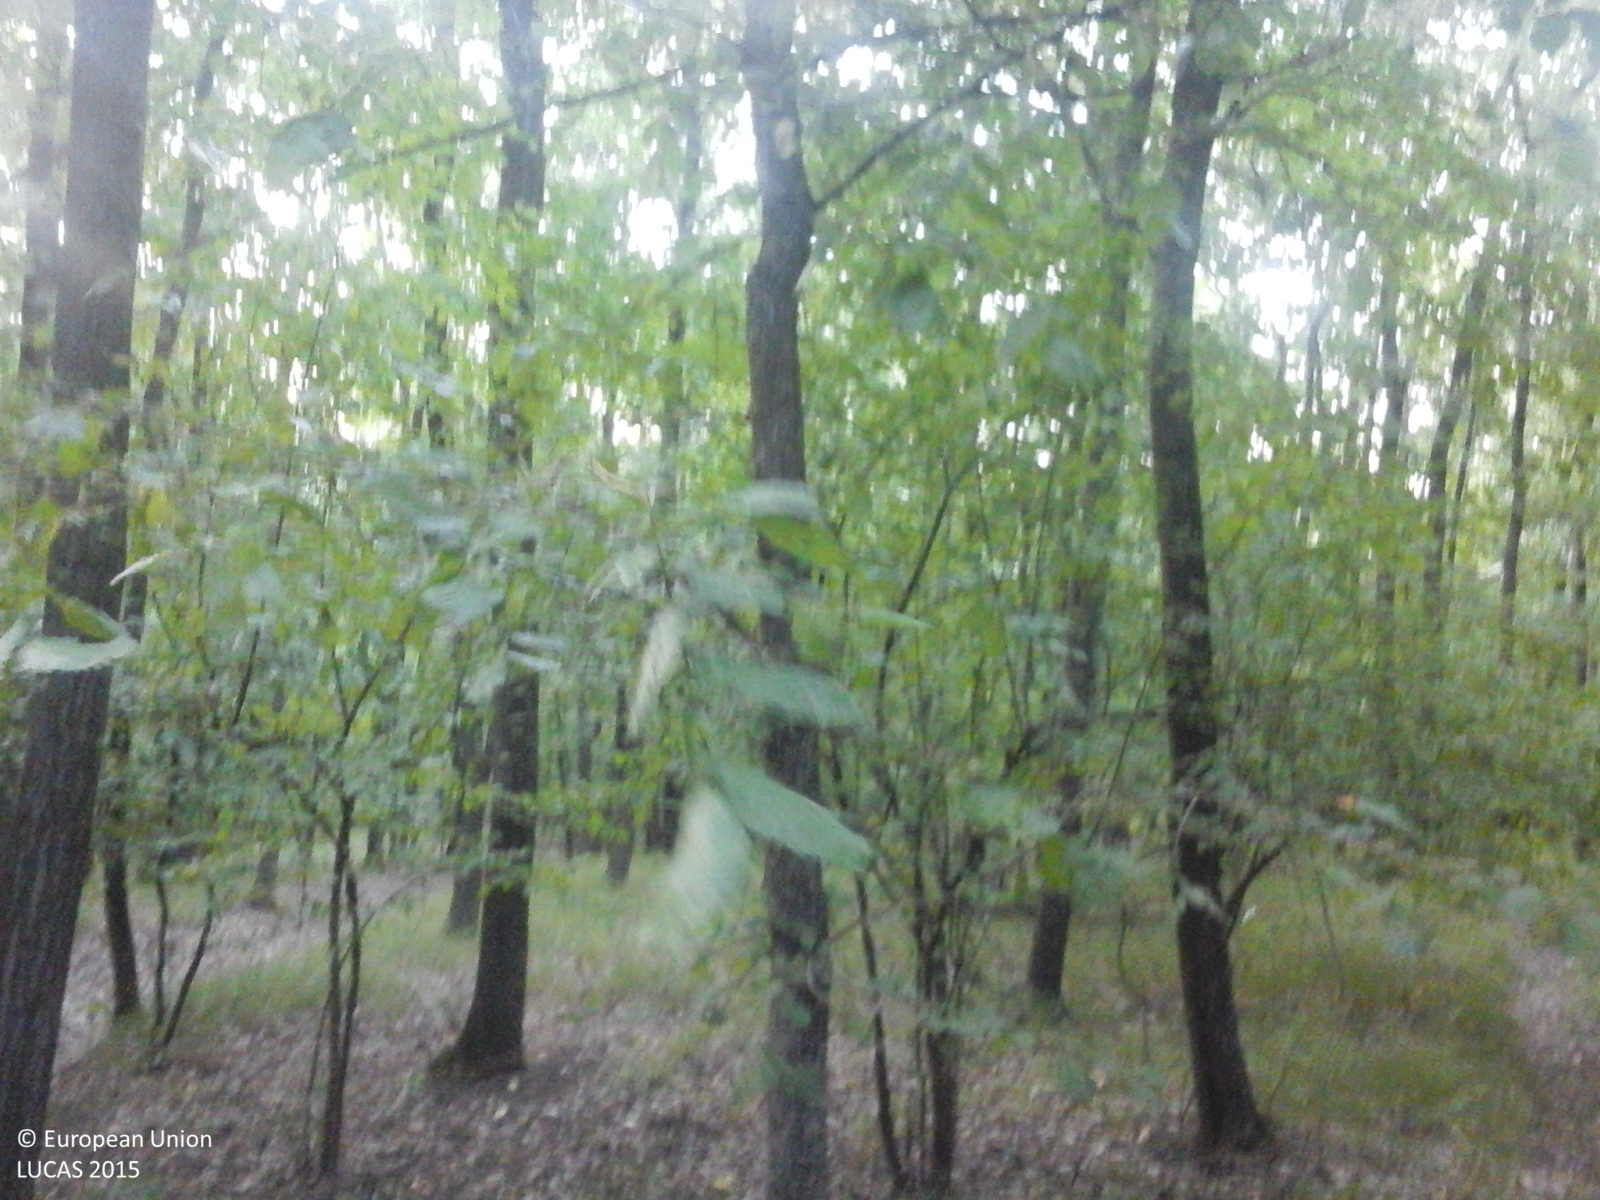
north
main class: Woodland
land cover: Broadleaved woodland
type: beech forest
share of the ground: > 75 %
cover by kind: broadleaved forest trees 100 %
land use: Forestry
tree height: > 5 m
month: June
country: RO
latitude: 47.1485
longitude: 26.9939
